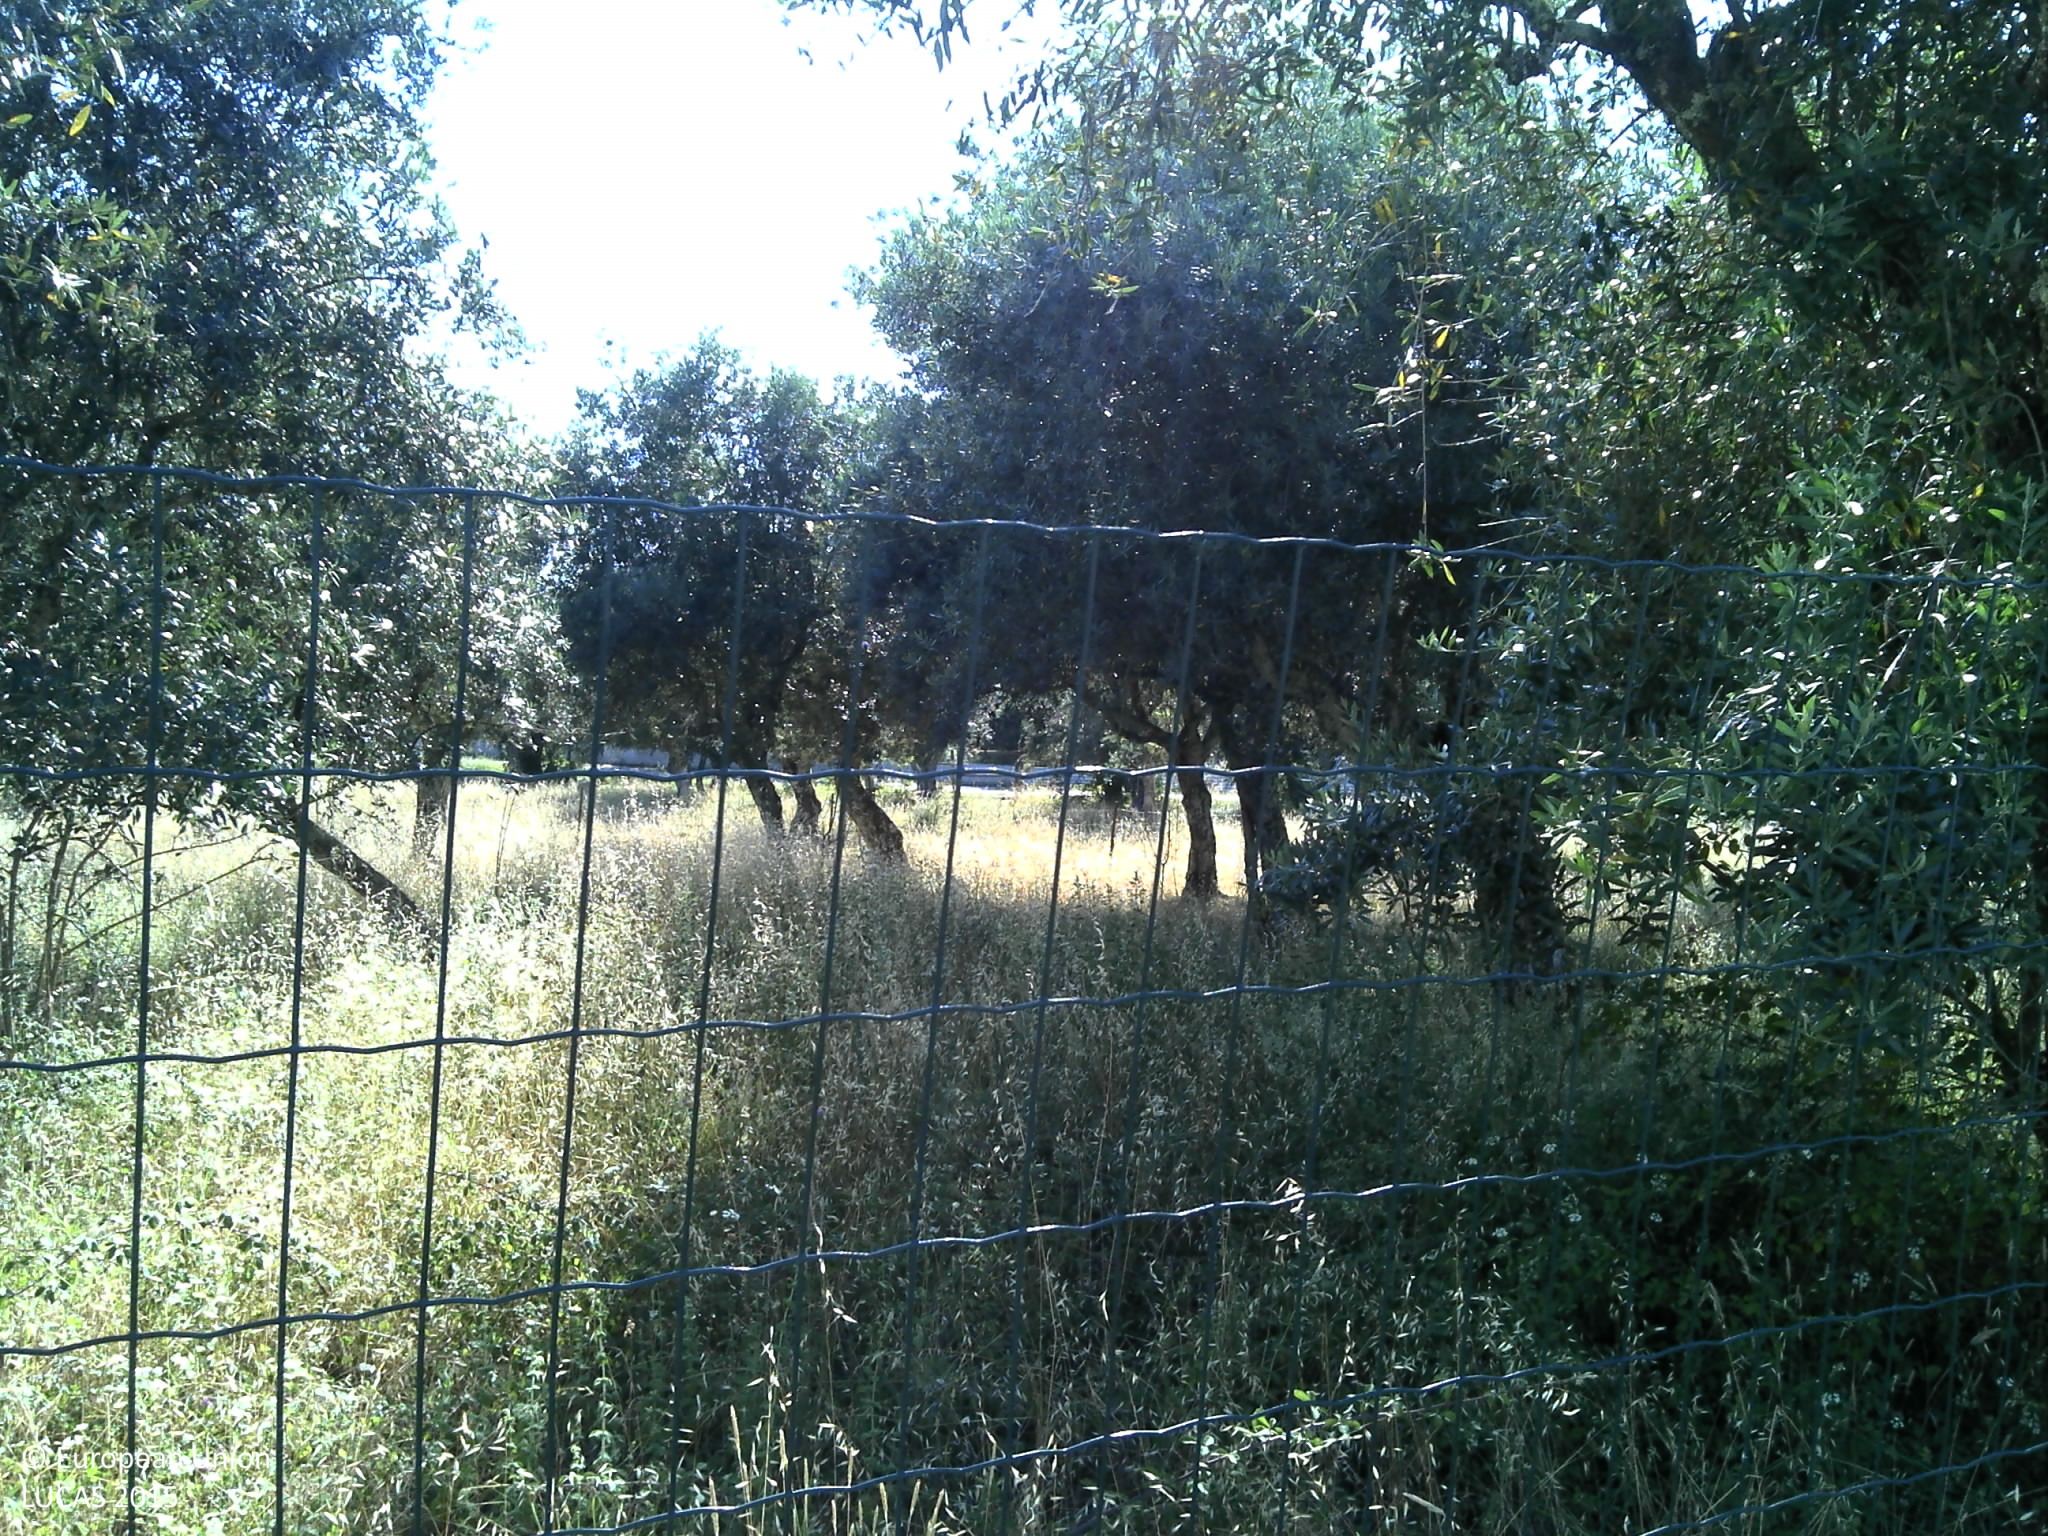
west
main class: Cropland
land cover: Olive groves
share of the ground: 25 - 50 %
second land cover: Grassland without tree/shrub cover
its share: 50 - 75 %
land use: Agriculture (excluding fallow land and kitchen gardens)
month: July
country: PT
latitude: 39.8171
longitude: -8.1410
